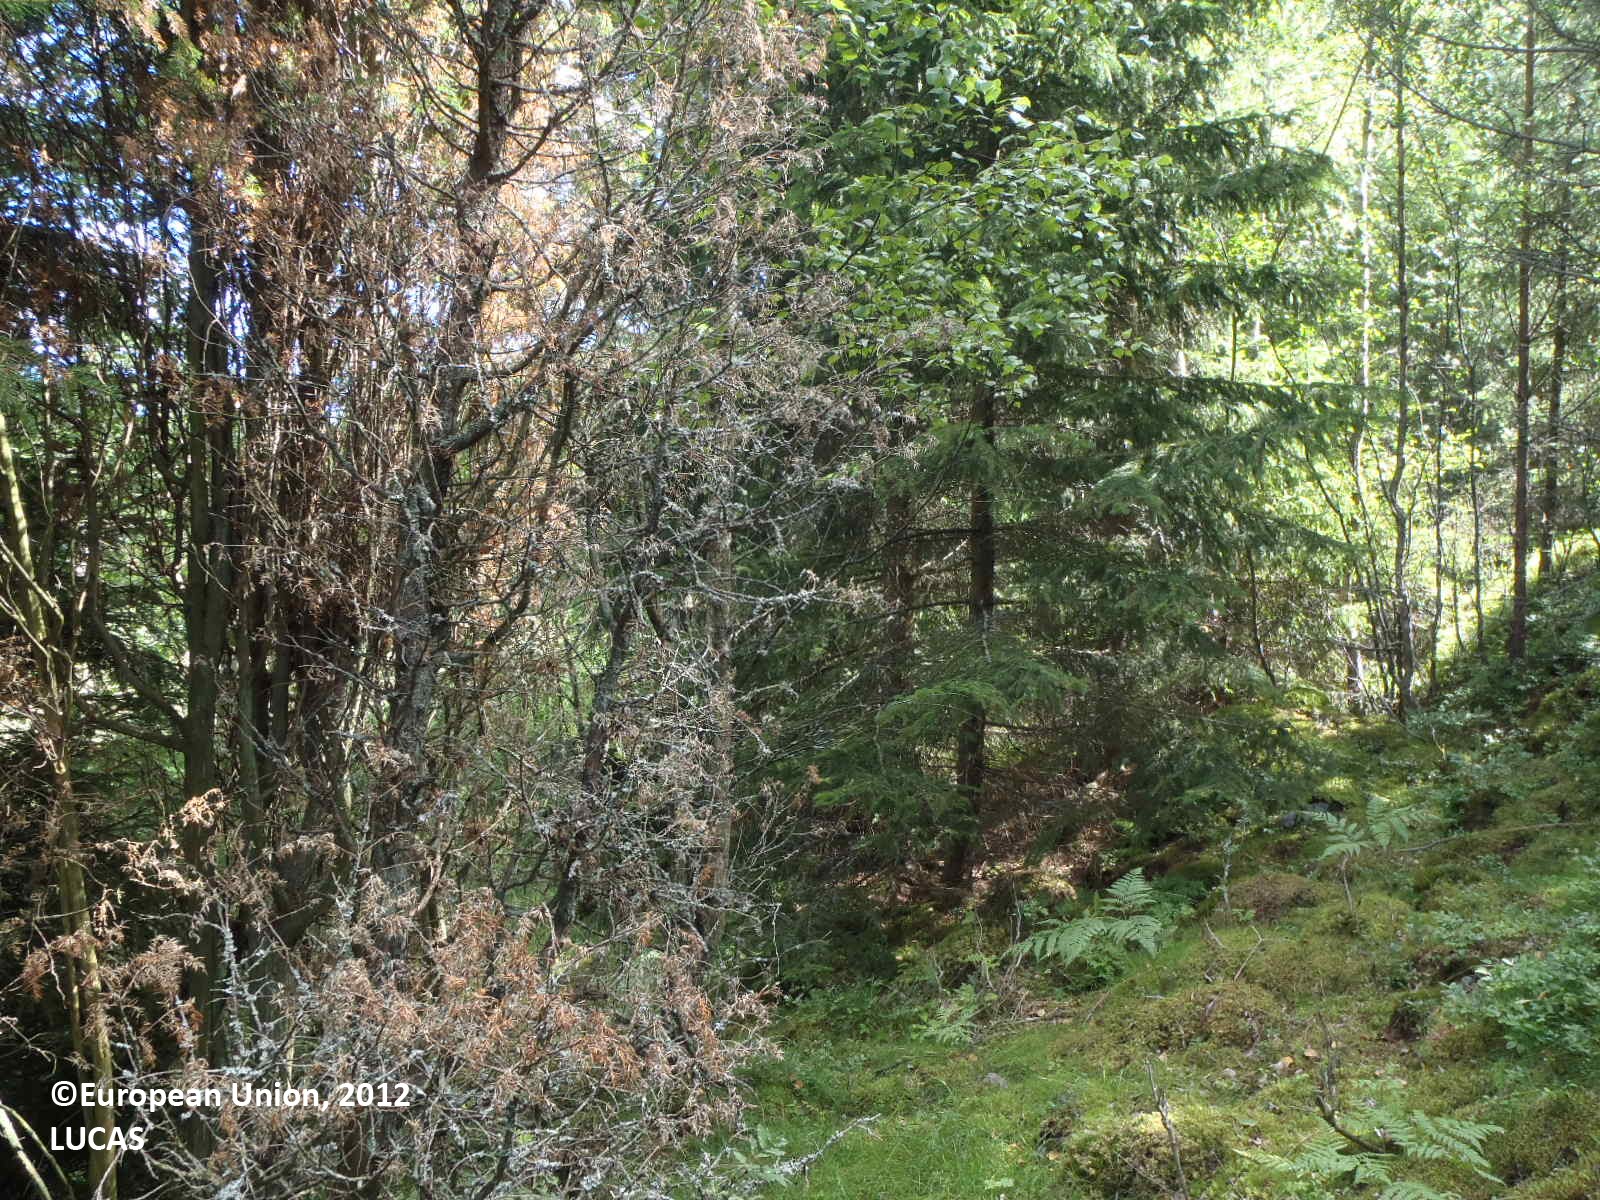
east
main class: Woodland
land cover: Spruce dominated mixed woodland
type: boreal forest
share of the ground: > 75 %
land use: Forestry
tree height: > 5 m
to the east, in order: Spruce dominated mixed woodland; Grass margins; Ditches and canals; Temporary grasslands; Grass margins; Ditches and canals; Grass margins; Pine dominated coniferous woodland; Paved roads, cycling and walking lanes; Pine dominated coniferous woodland
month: August
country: FI
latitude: 60.1224
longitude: 21.9972
